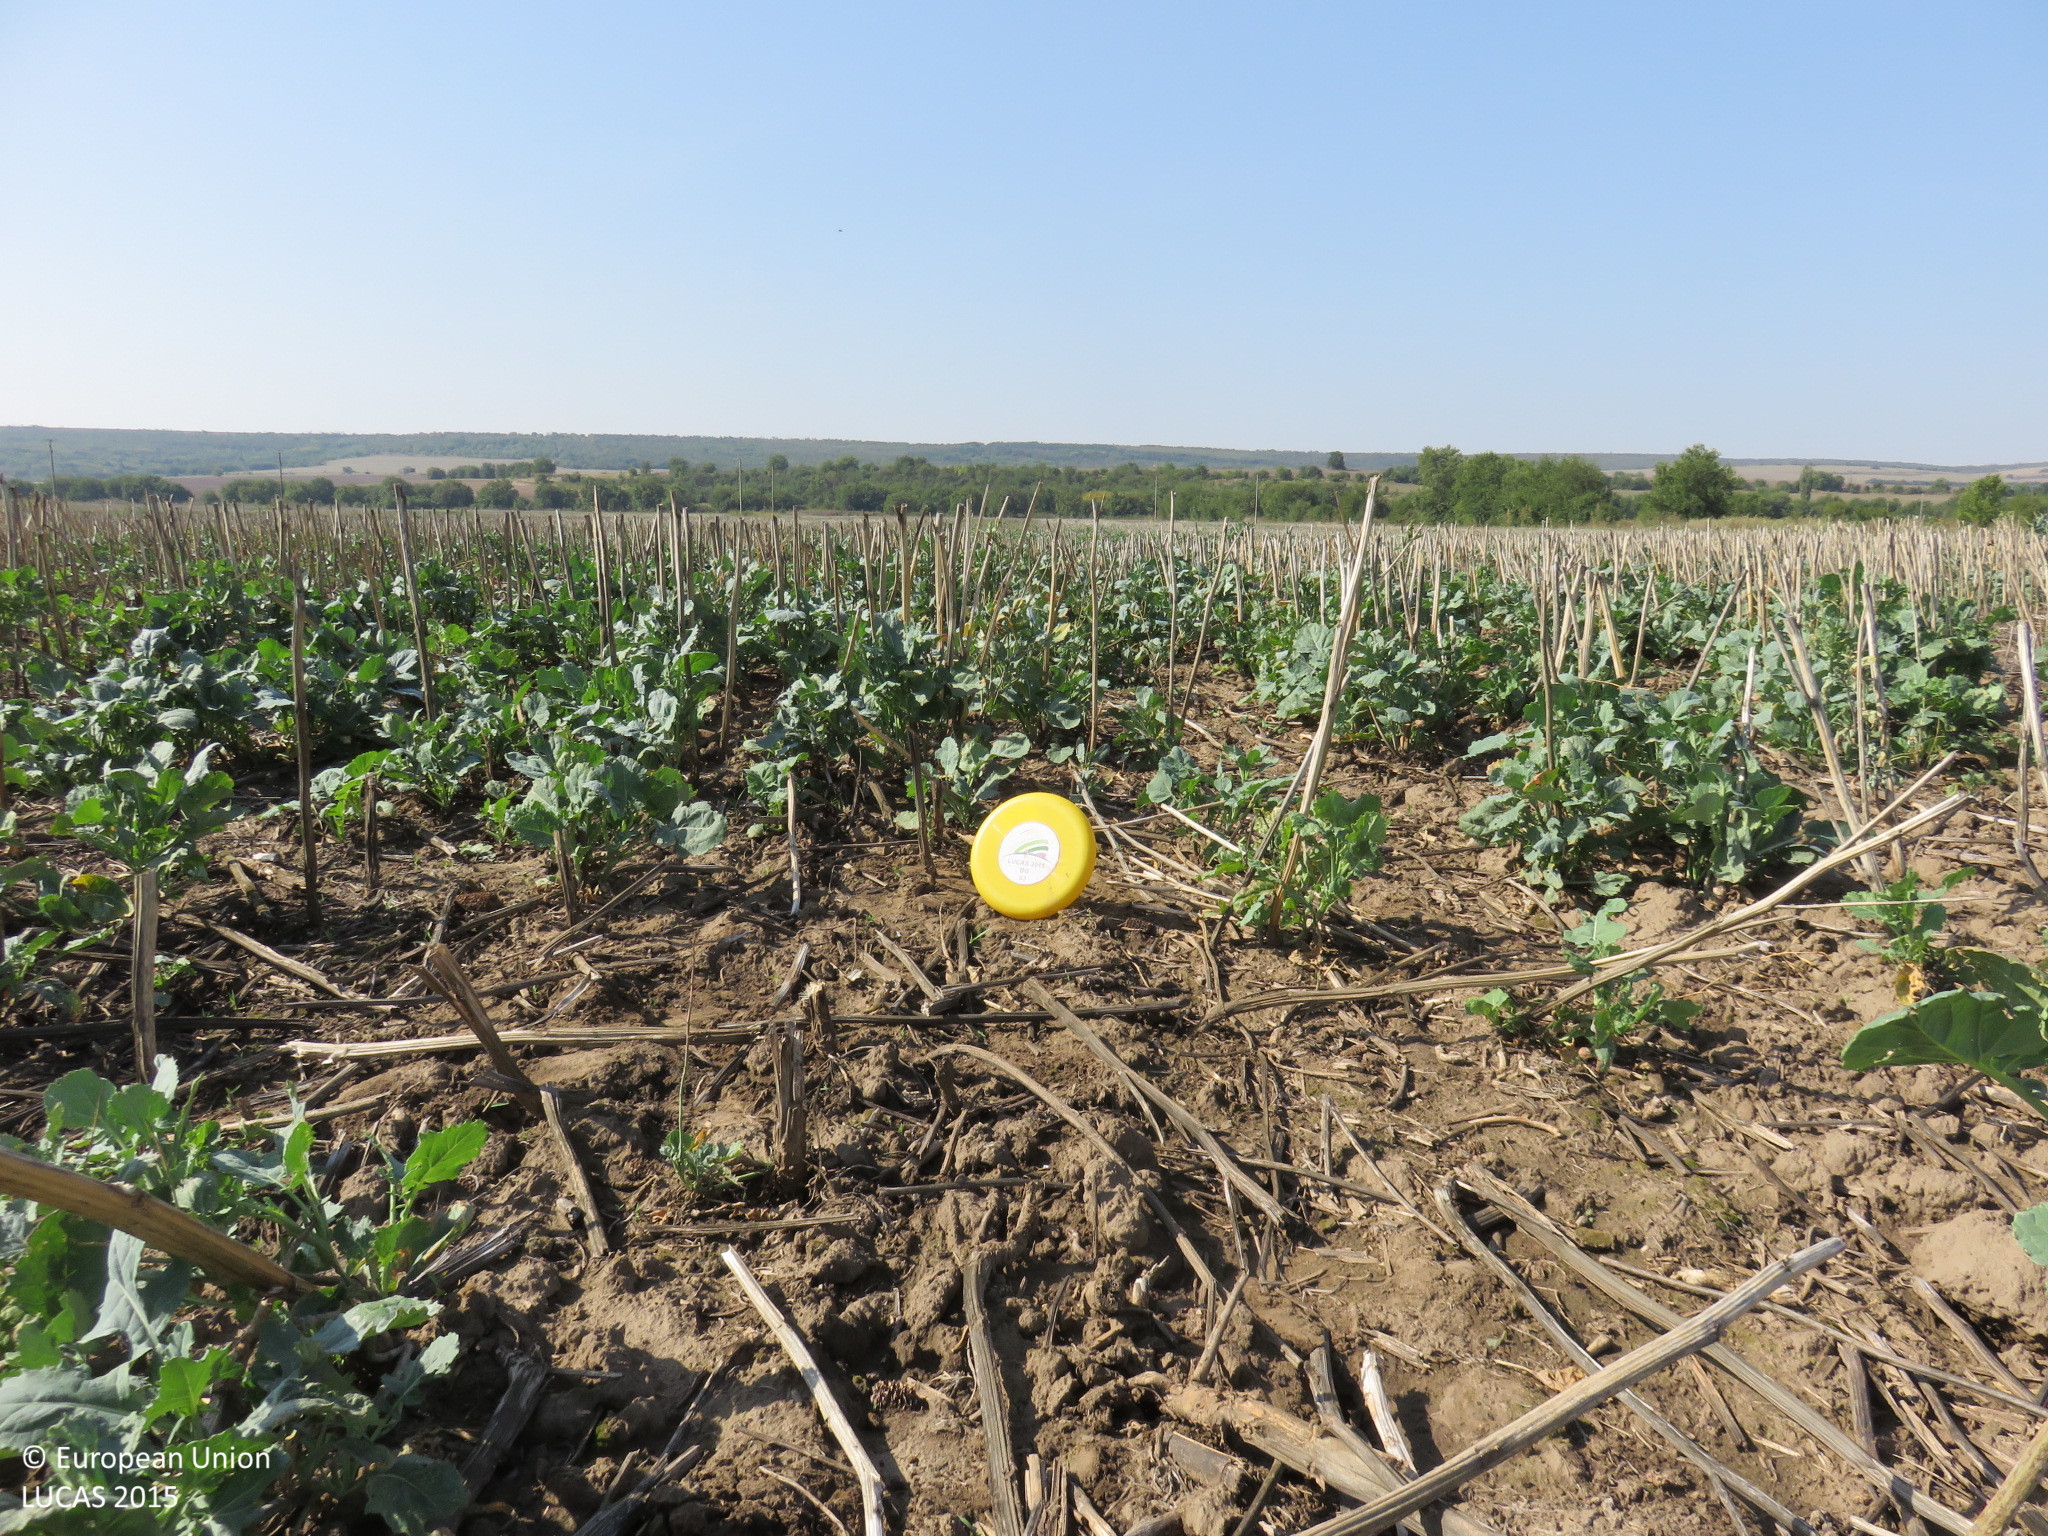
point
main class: Cropland
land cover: Rape and turnip rape
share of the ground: 50 - 75 %
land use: Agriculture (excluding fallow land and kitchen gardens)
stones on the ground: < 10 %
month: September
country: BG
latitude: 43.6647
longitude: 24.5615
